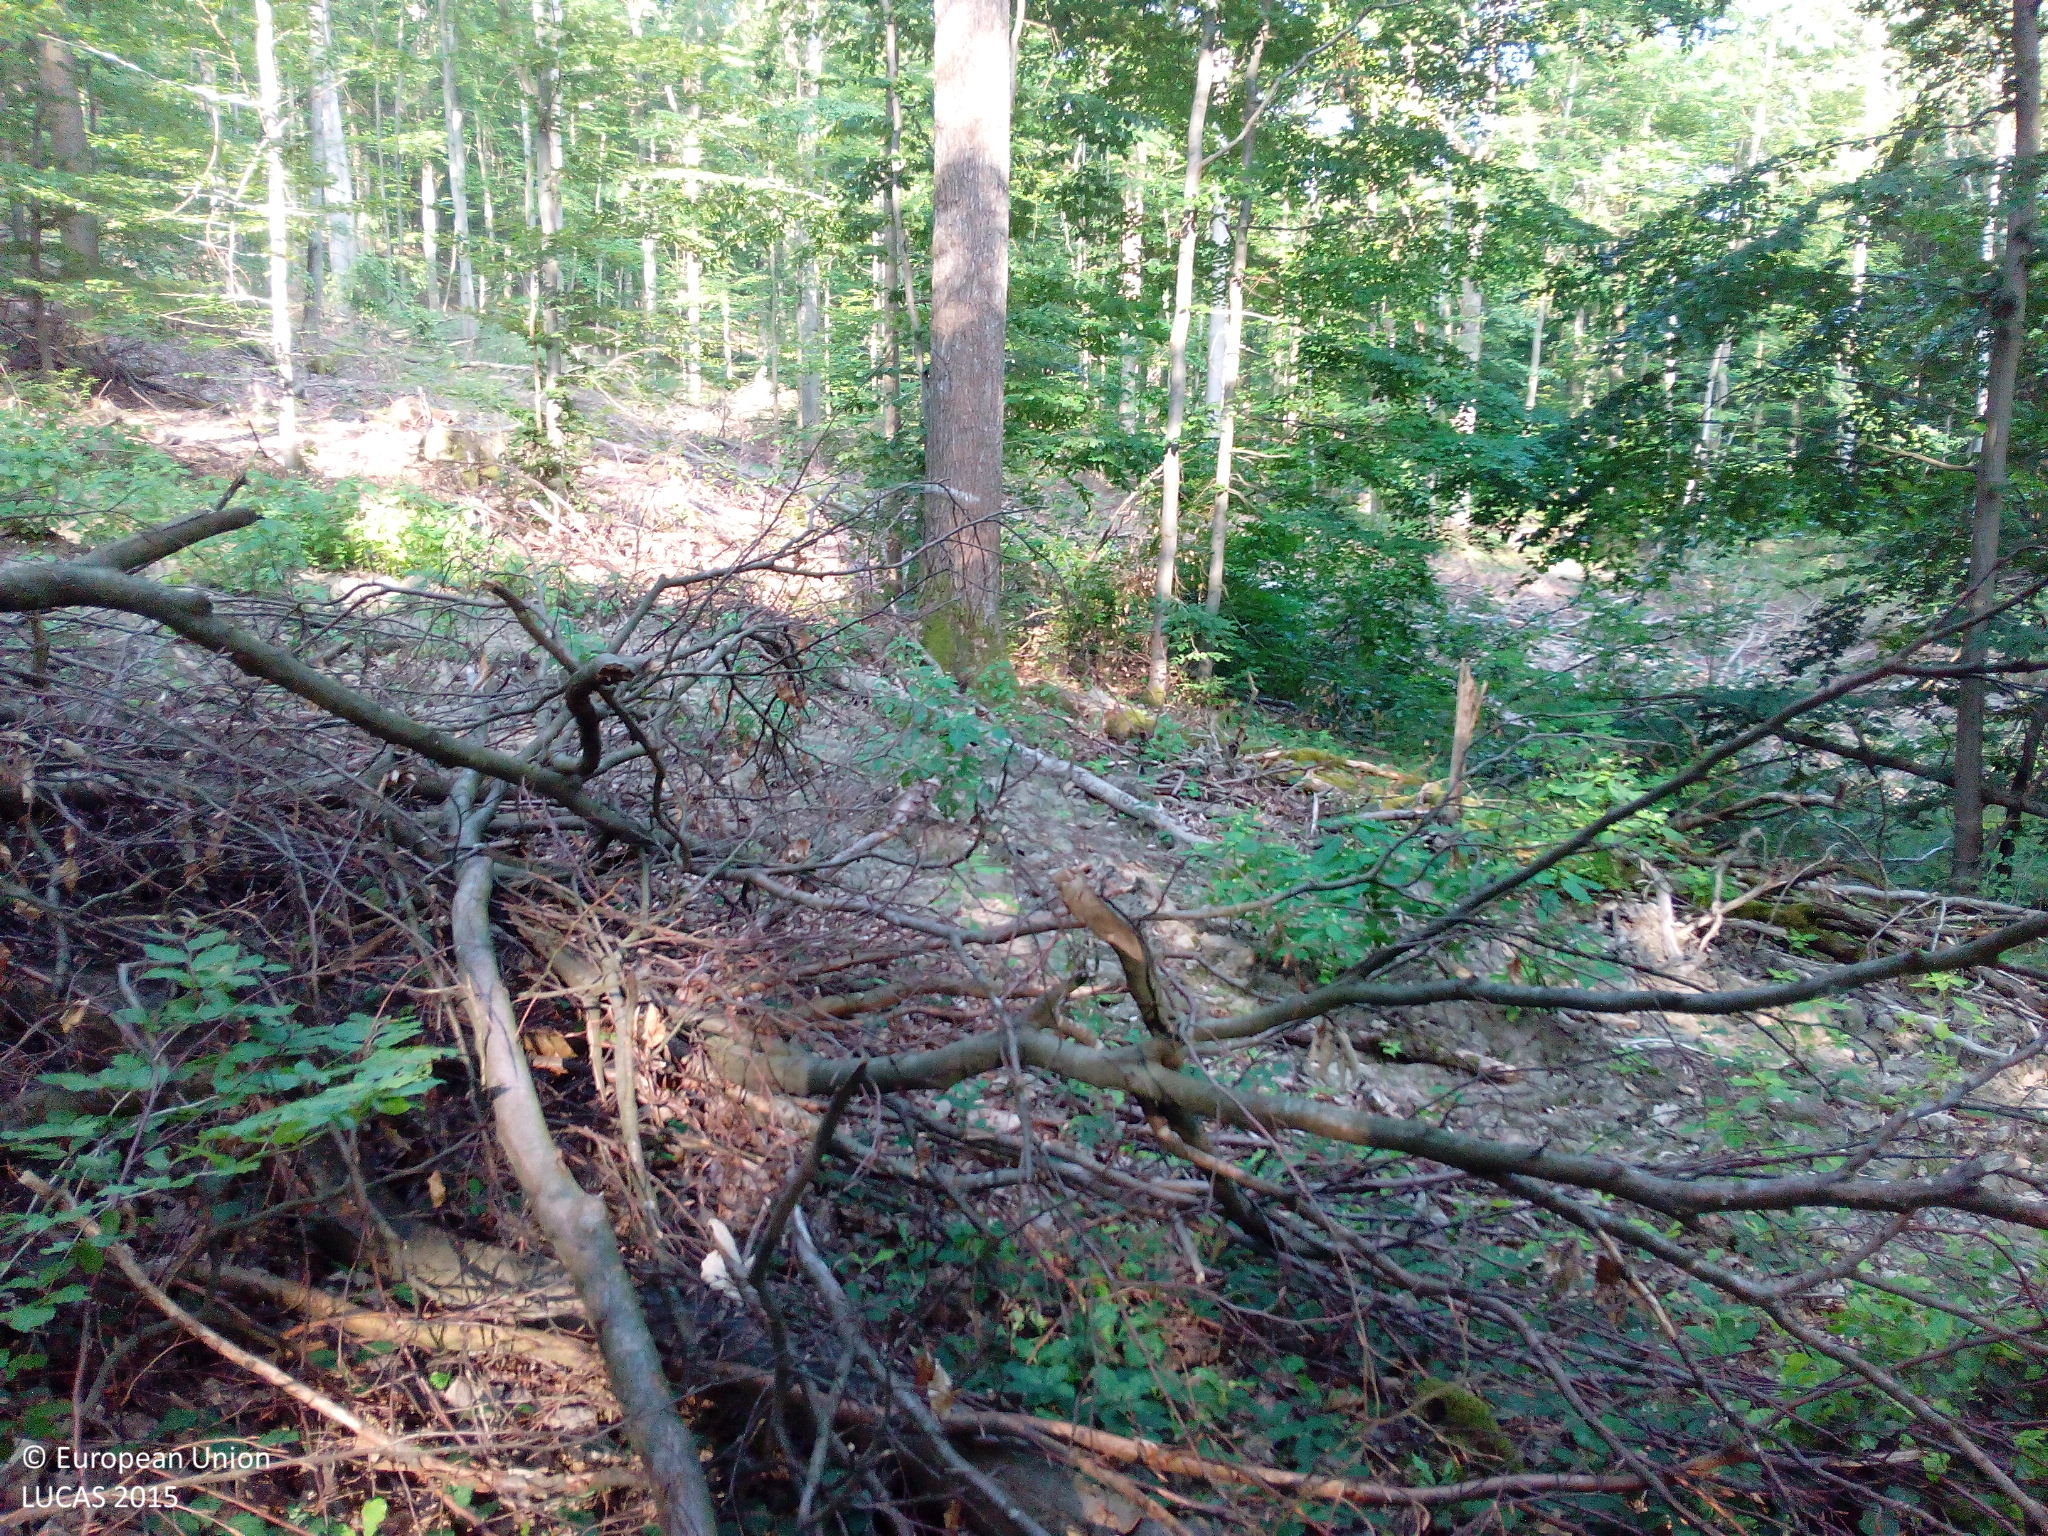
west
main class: Woodland
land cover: Broadleaved woodland
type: mesophytic deciduous forest
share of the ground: > 75 %
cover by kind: broadleaved forest trees 80 %, herbaceous plants 15 %, unconsolidated bare surface 5 %
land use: Forestry
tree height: > 5 m
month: July
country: DE
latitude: 49.8389
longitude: 10.9035
